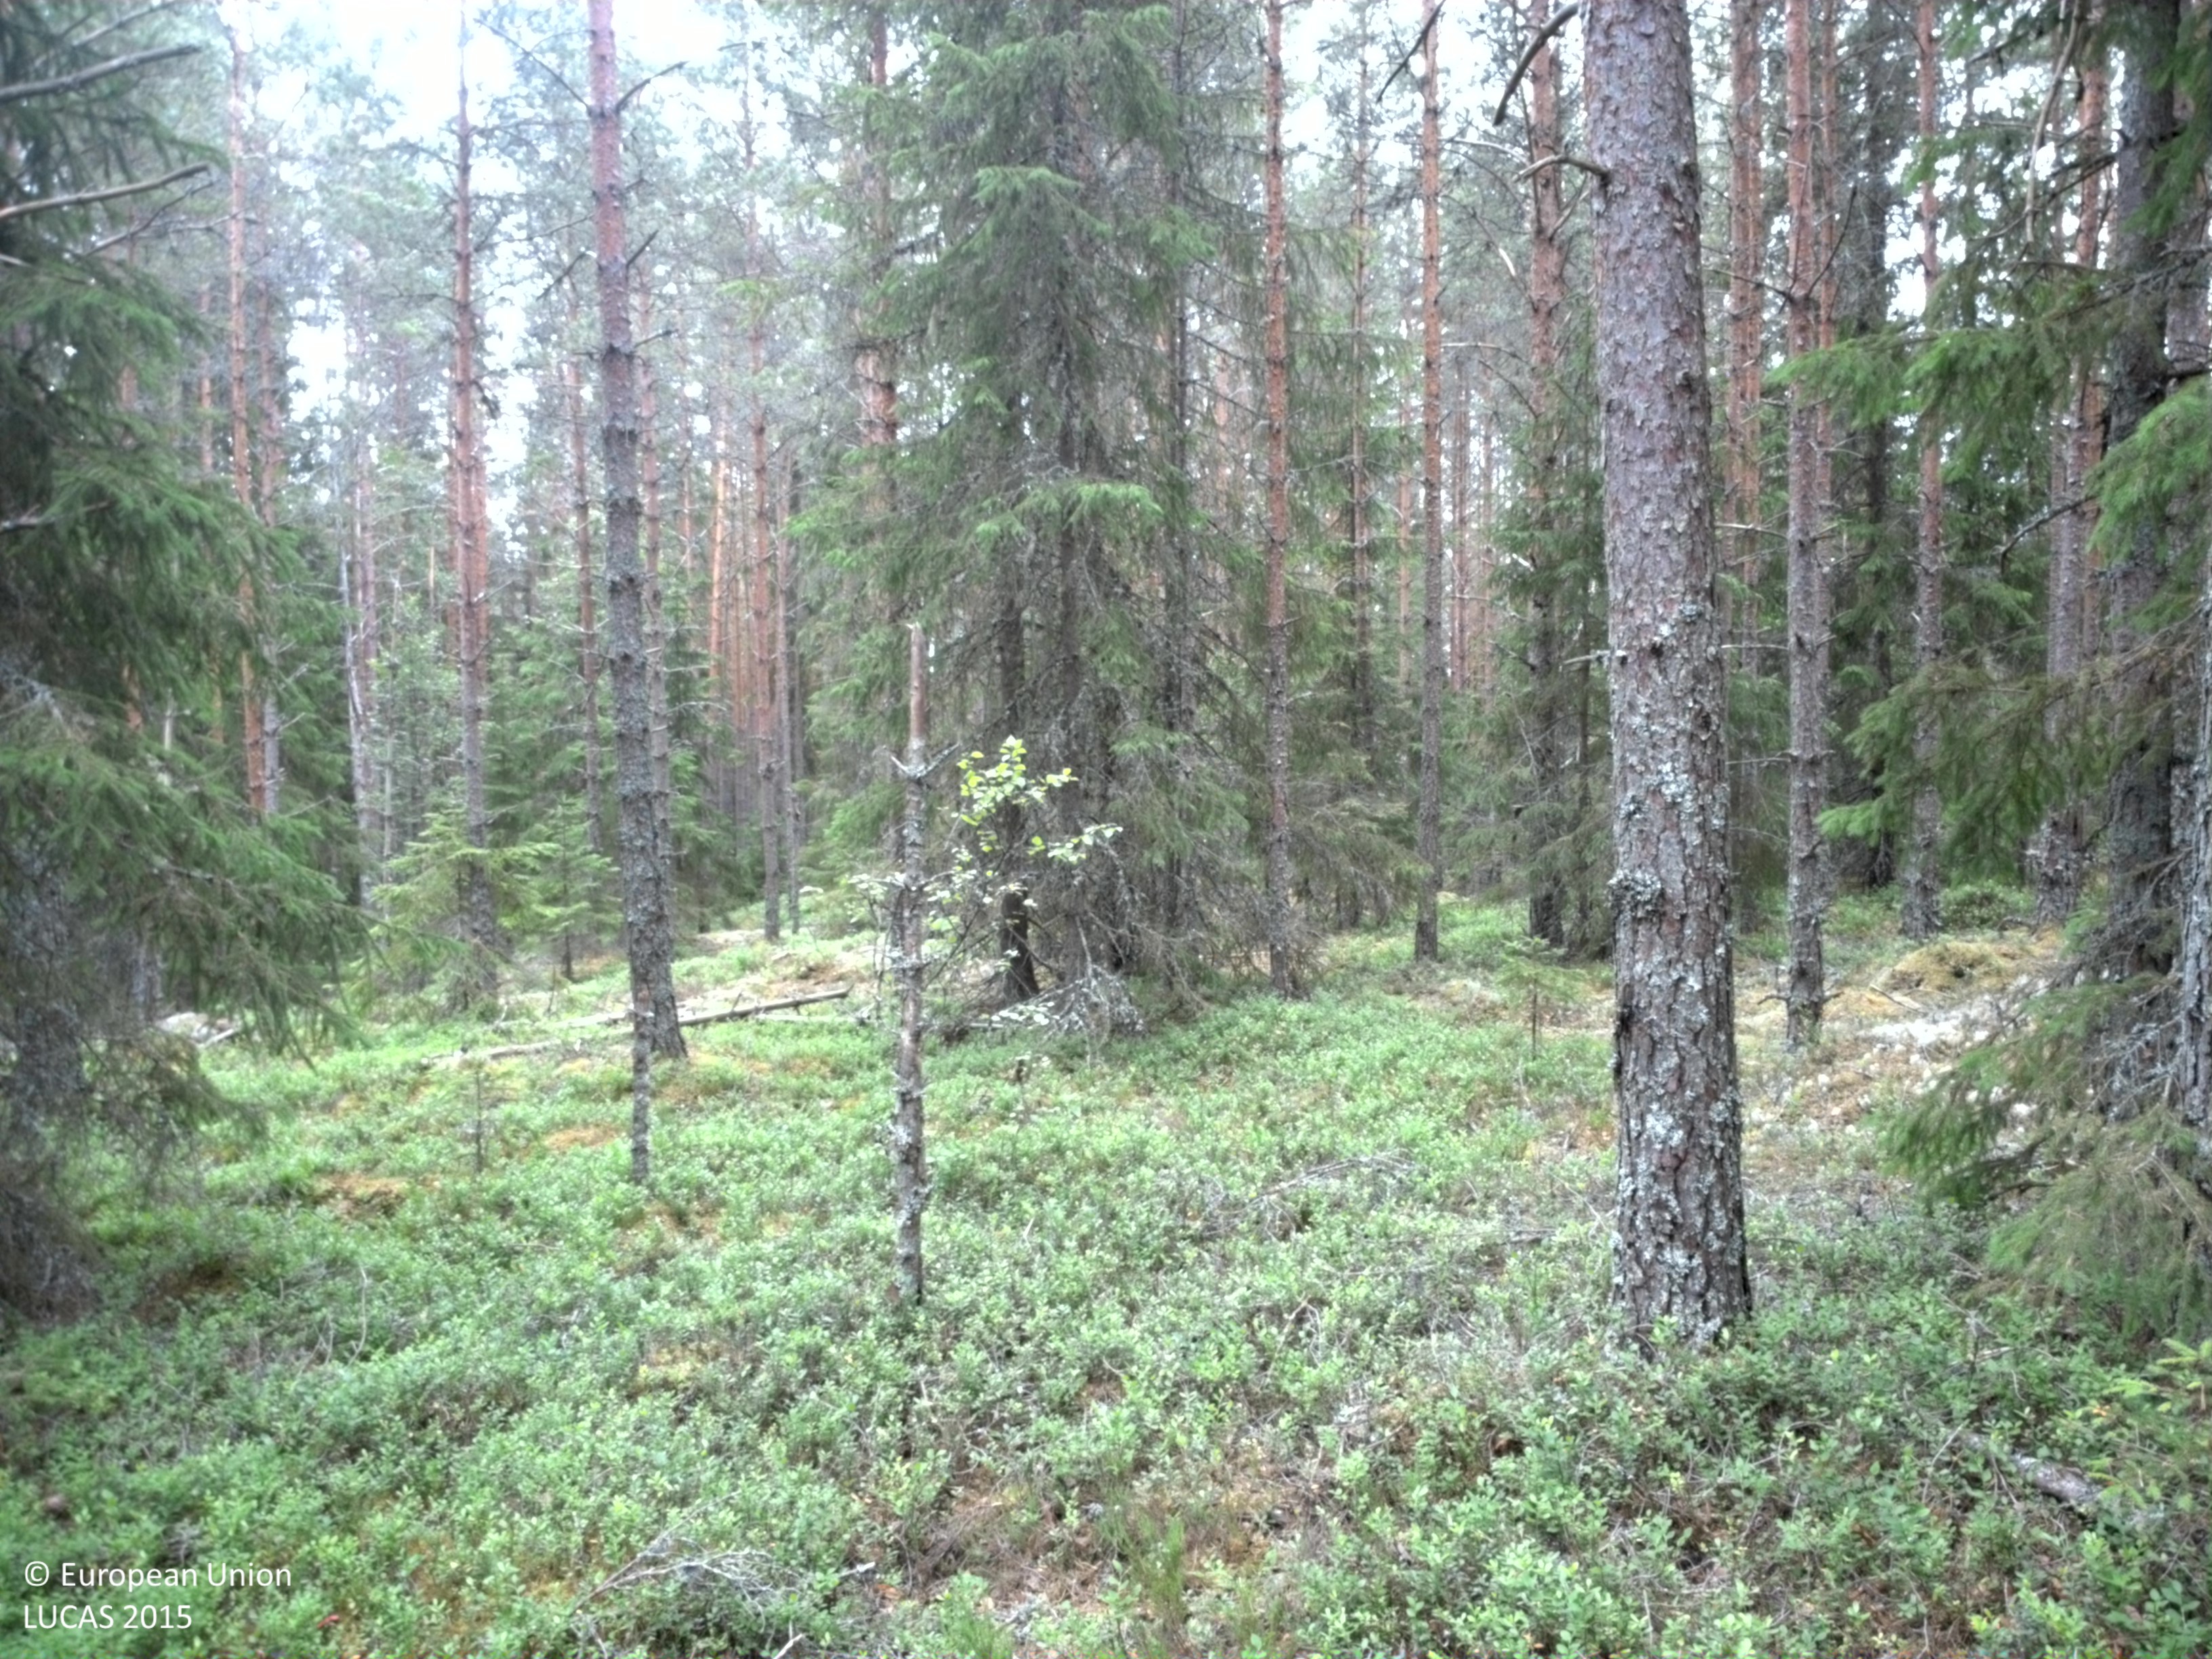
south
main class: Woodland
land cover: Pine dominated coniferous woodland
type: boreal forest
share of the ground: 25 - 50 %
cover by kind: coniferous forest trees 50 %, shrubs 25 %, lichens and mosses 20 %, herbaceous plants 5 %
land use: Forestry
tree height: > 5 m
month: July
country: SE
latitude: 59.6638
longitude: 11.8941
